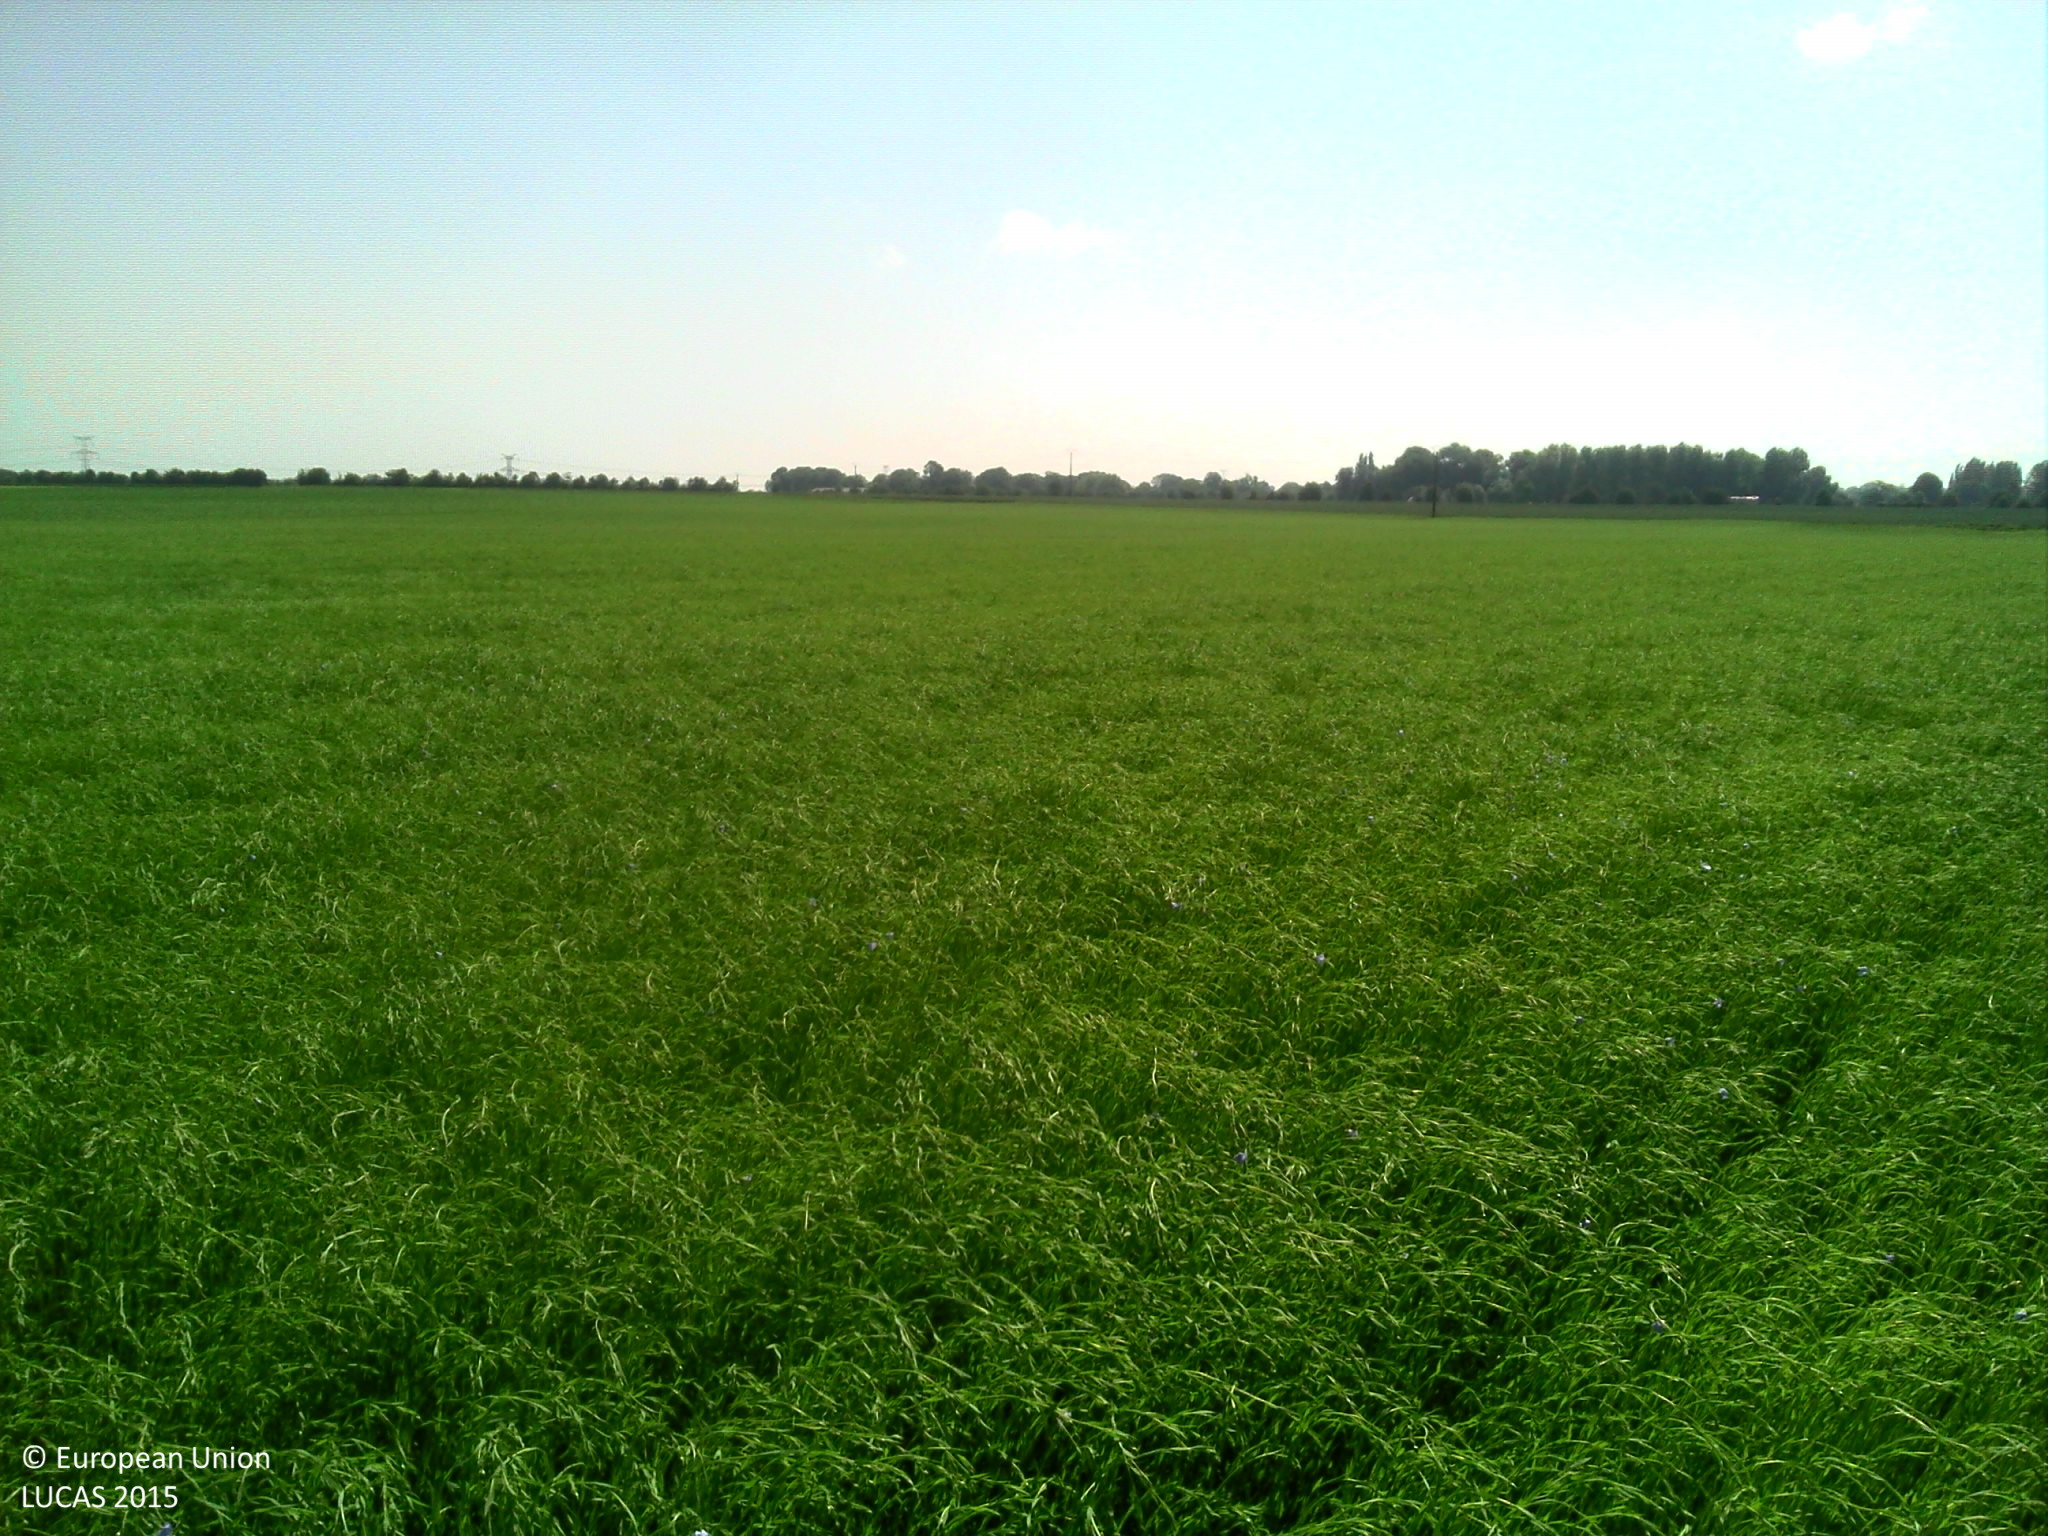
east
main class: Cropland
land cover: Other fibre and oleaginous crops
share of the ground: > 75 %
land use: Agriculture (excluding fallow land and kitchen gardens)
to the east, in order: Other fibre and oleaginous crops
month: June
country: FR
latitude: 50.0262
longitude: 1.7050
